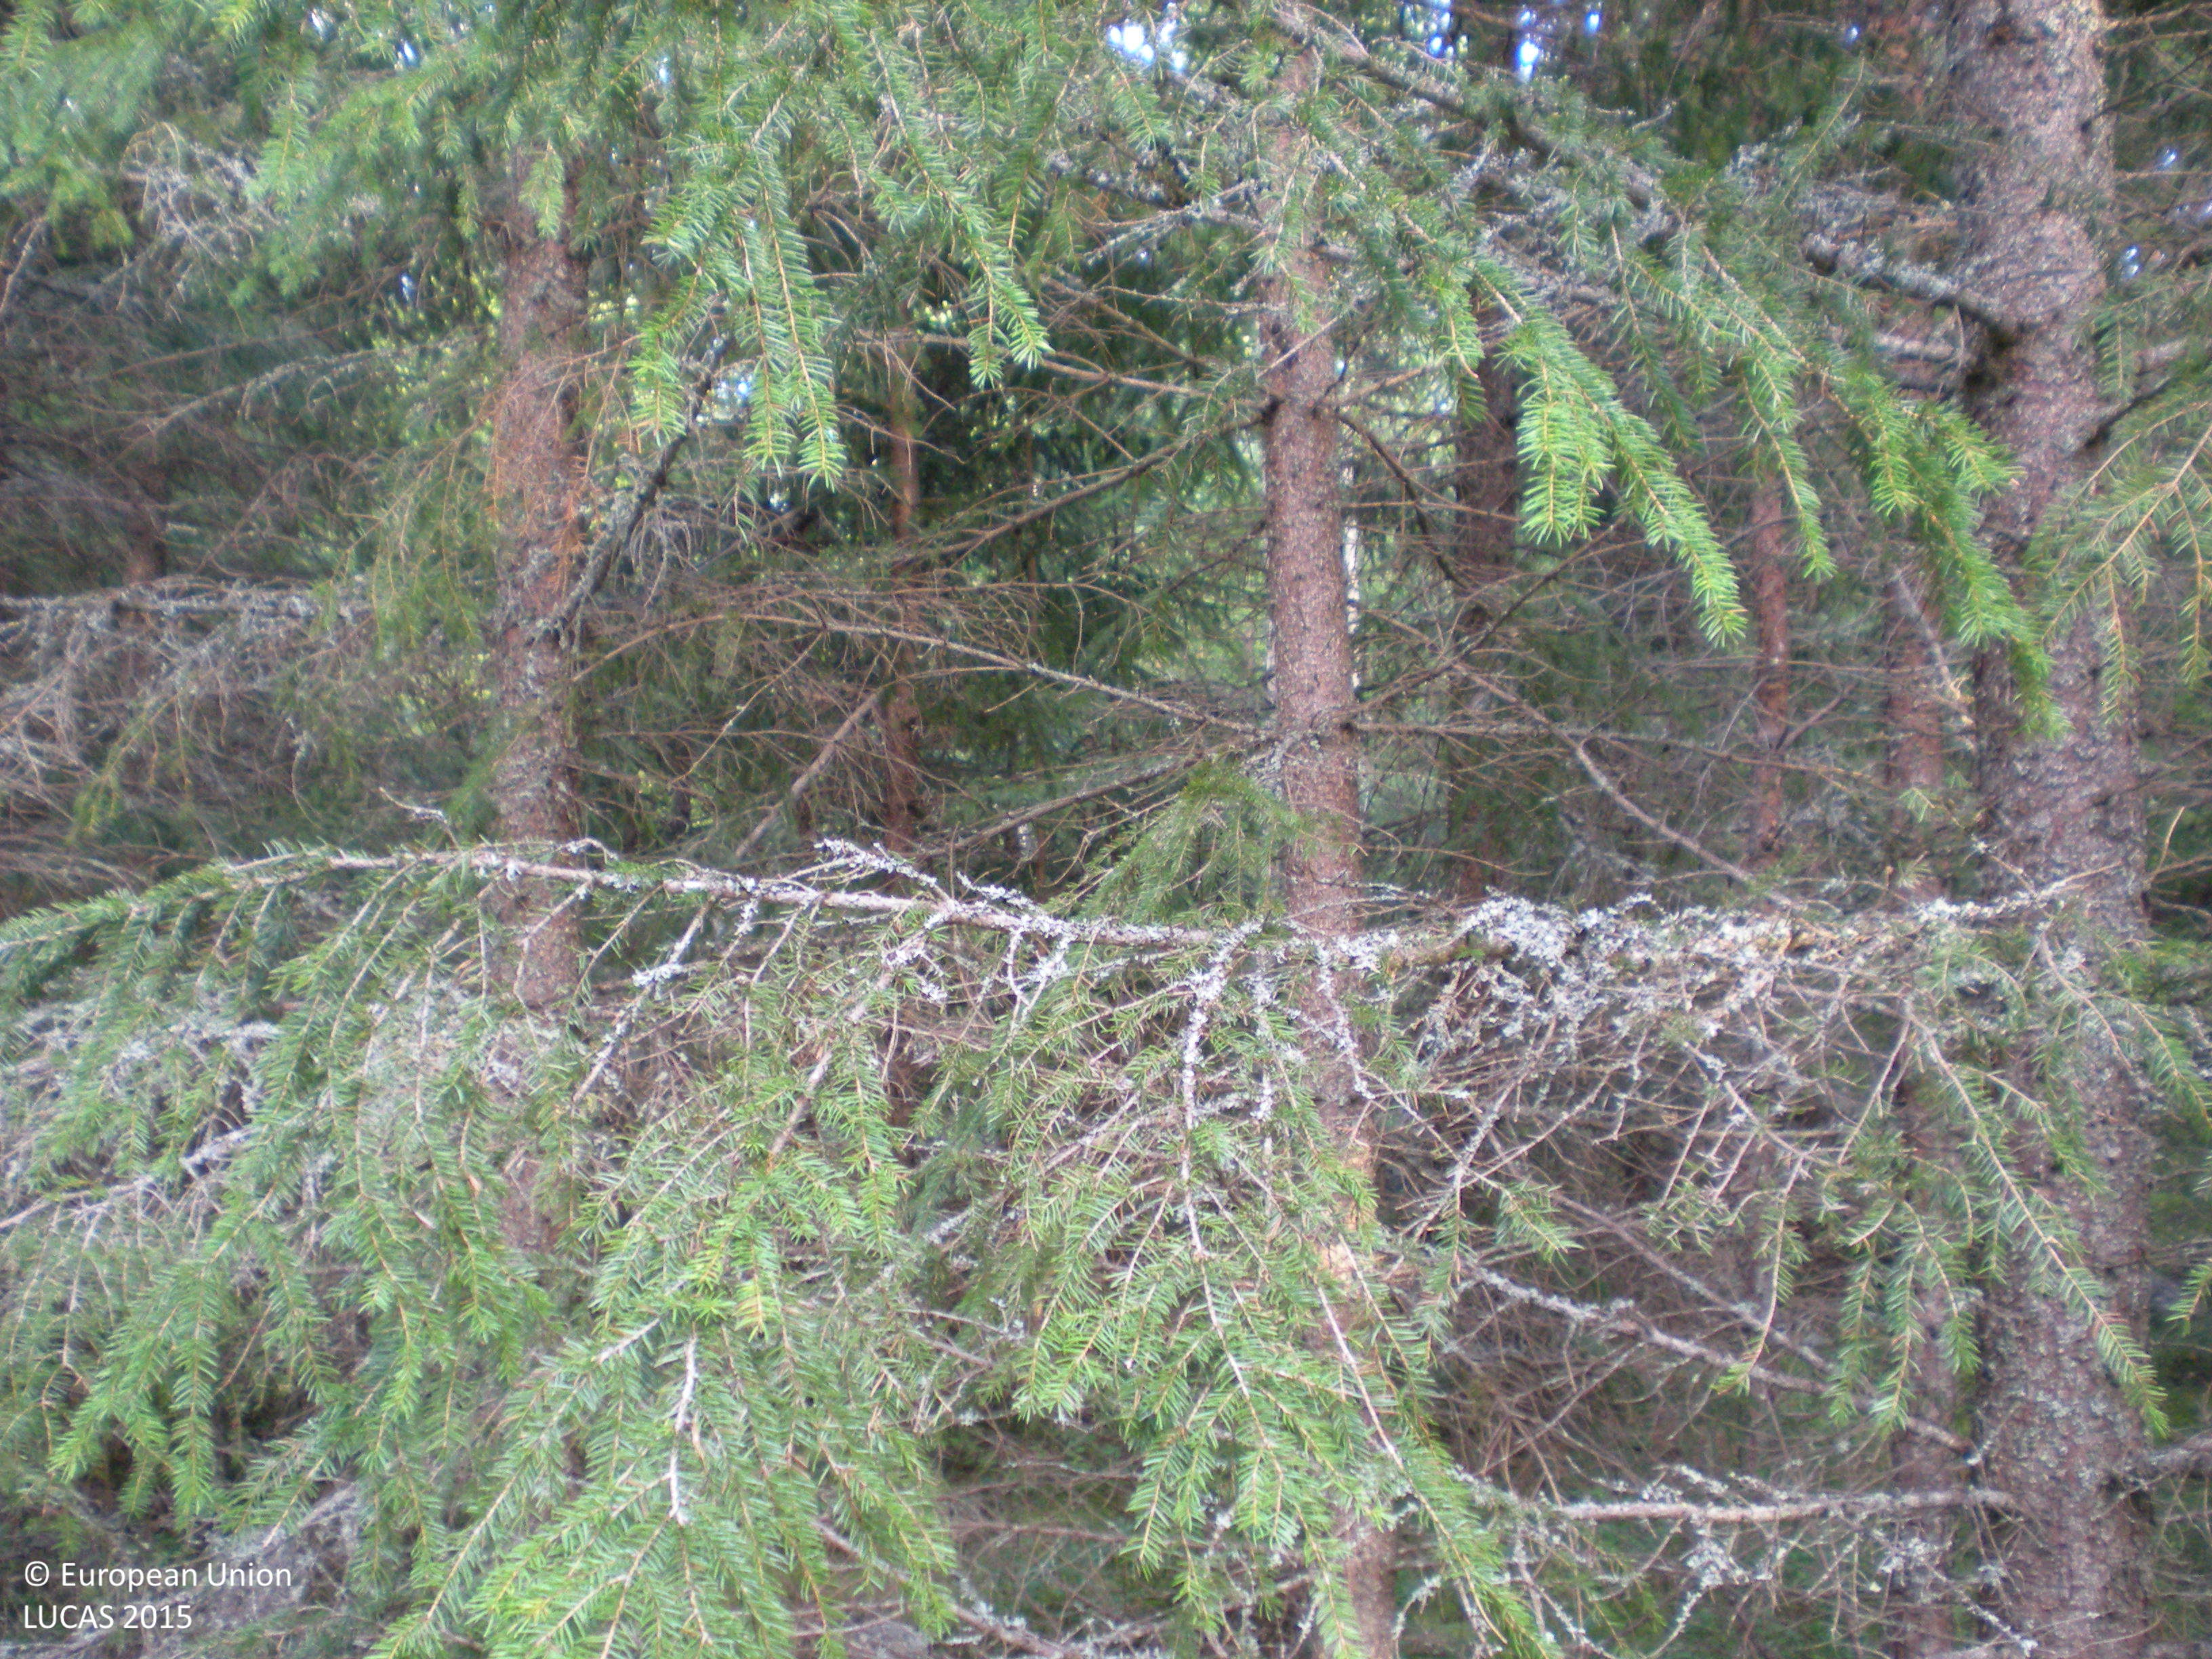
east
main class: Woodland
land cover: Spruce dominated coniferous woodland
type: boreal forest
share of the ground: 50 - 75 %
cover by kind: coniferous forest trees 65 %, herbaceous plants 15 %, broadleaved forest trees 5 %, shrubs 5 %, lichens and mosses 5 %, consolidated bare surface 5 %
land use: Forestry
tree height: > 5 m
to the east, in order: Spruce dominated coniferous woodland; Spruce dominated mixed woodland; Broadleaved woodland; Pine dominated mixed woodland
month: August
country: SE
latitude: 60.4325
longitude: 17.1665
